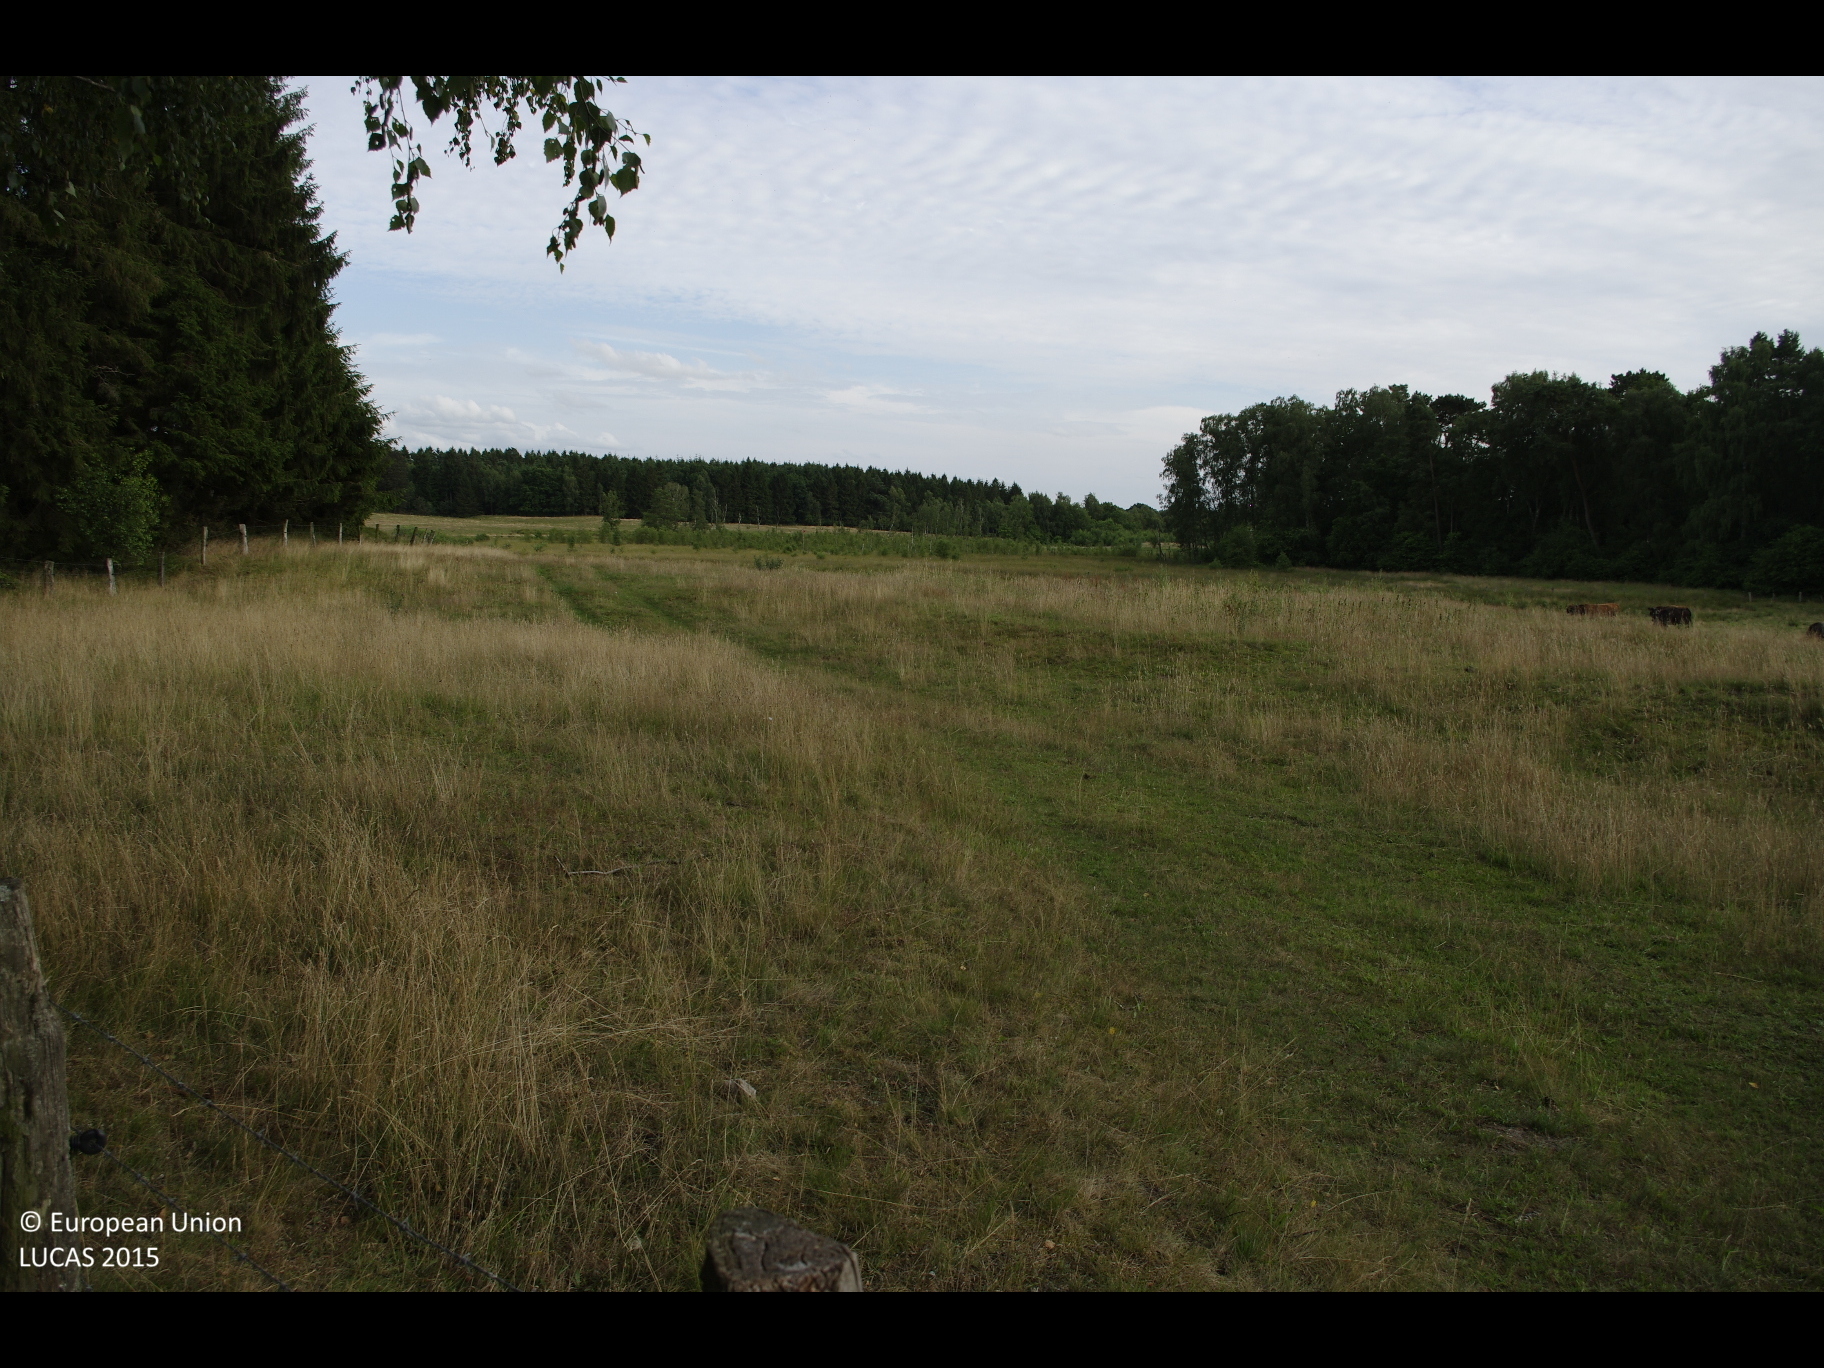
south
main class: Grassland
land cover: Grassland without tree/shrub cover
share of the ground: > 75 %
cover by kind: herbaceous plants 100 %
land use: Agriculture (excluding fallow land and kitchen gardens)
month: July
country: DE
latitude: 53.9411
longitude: 9.9239
